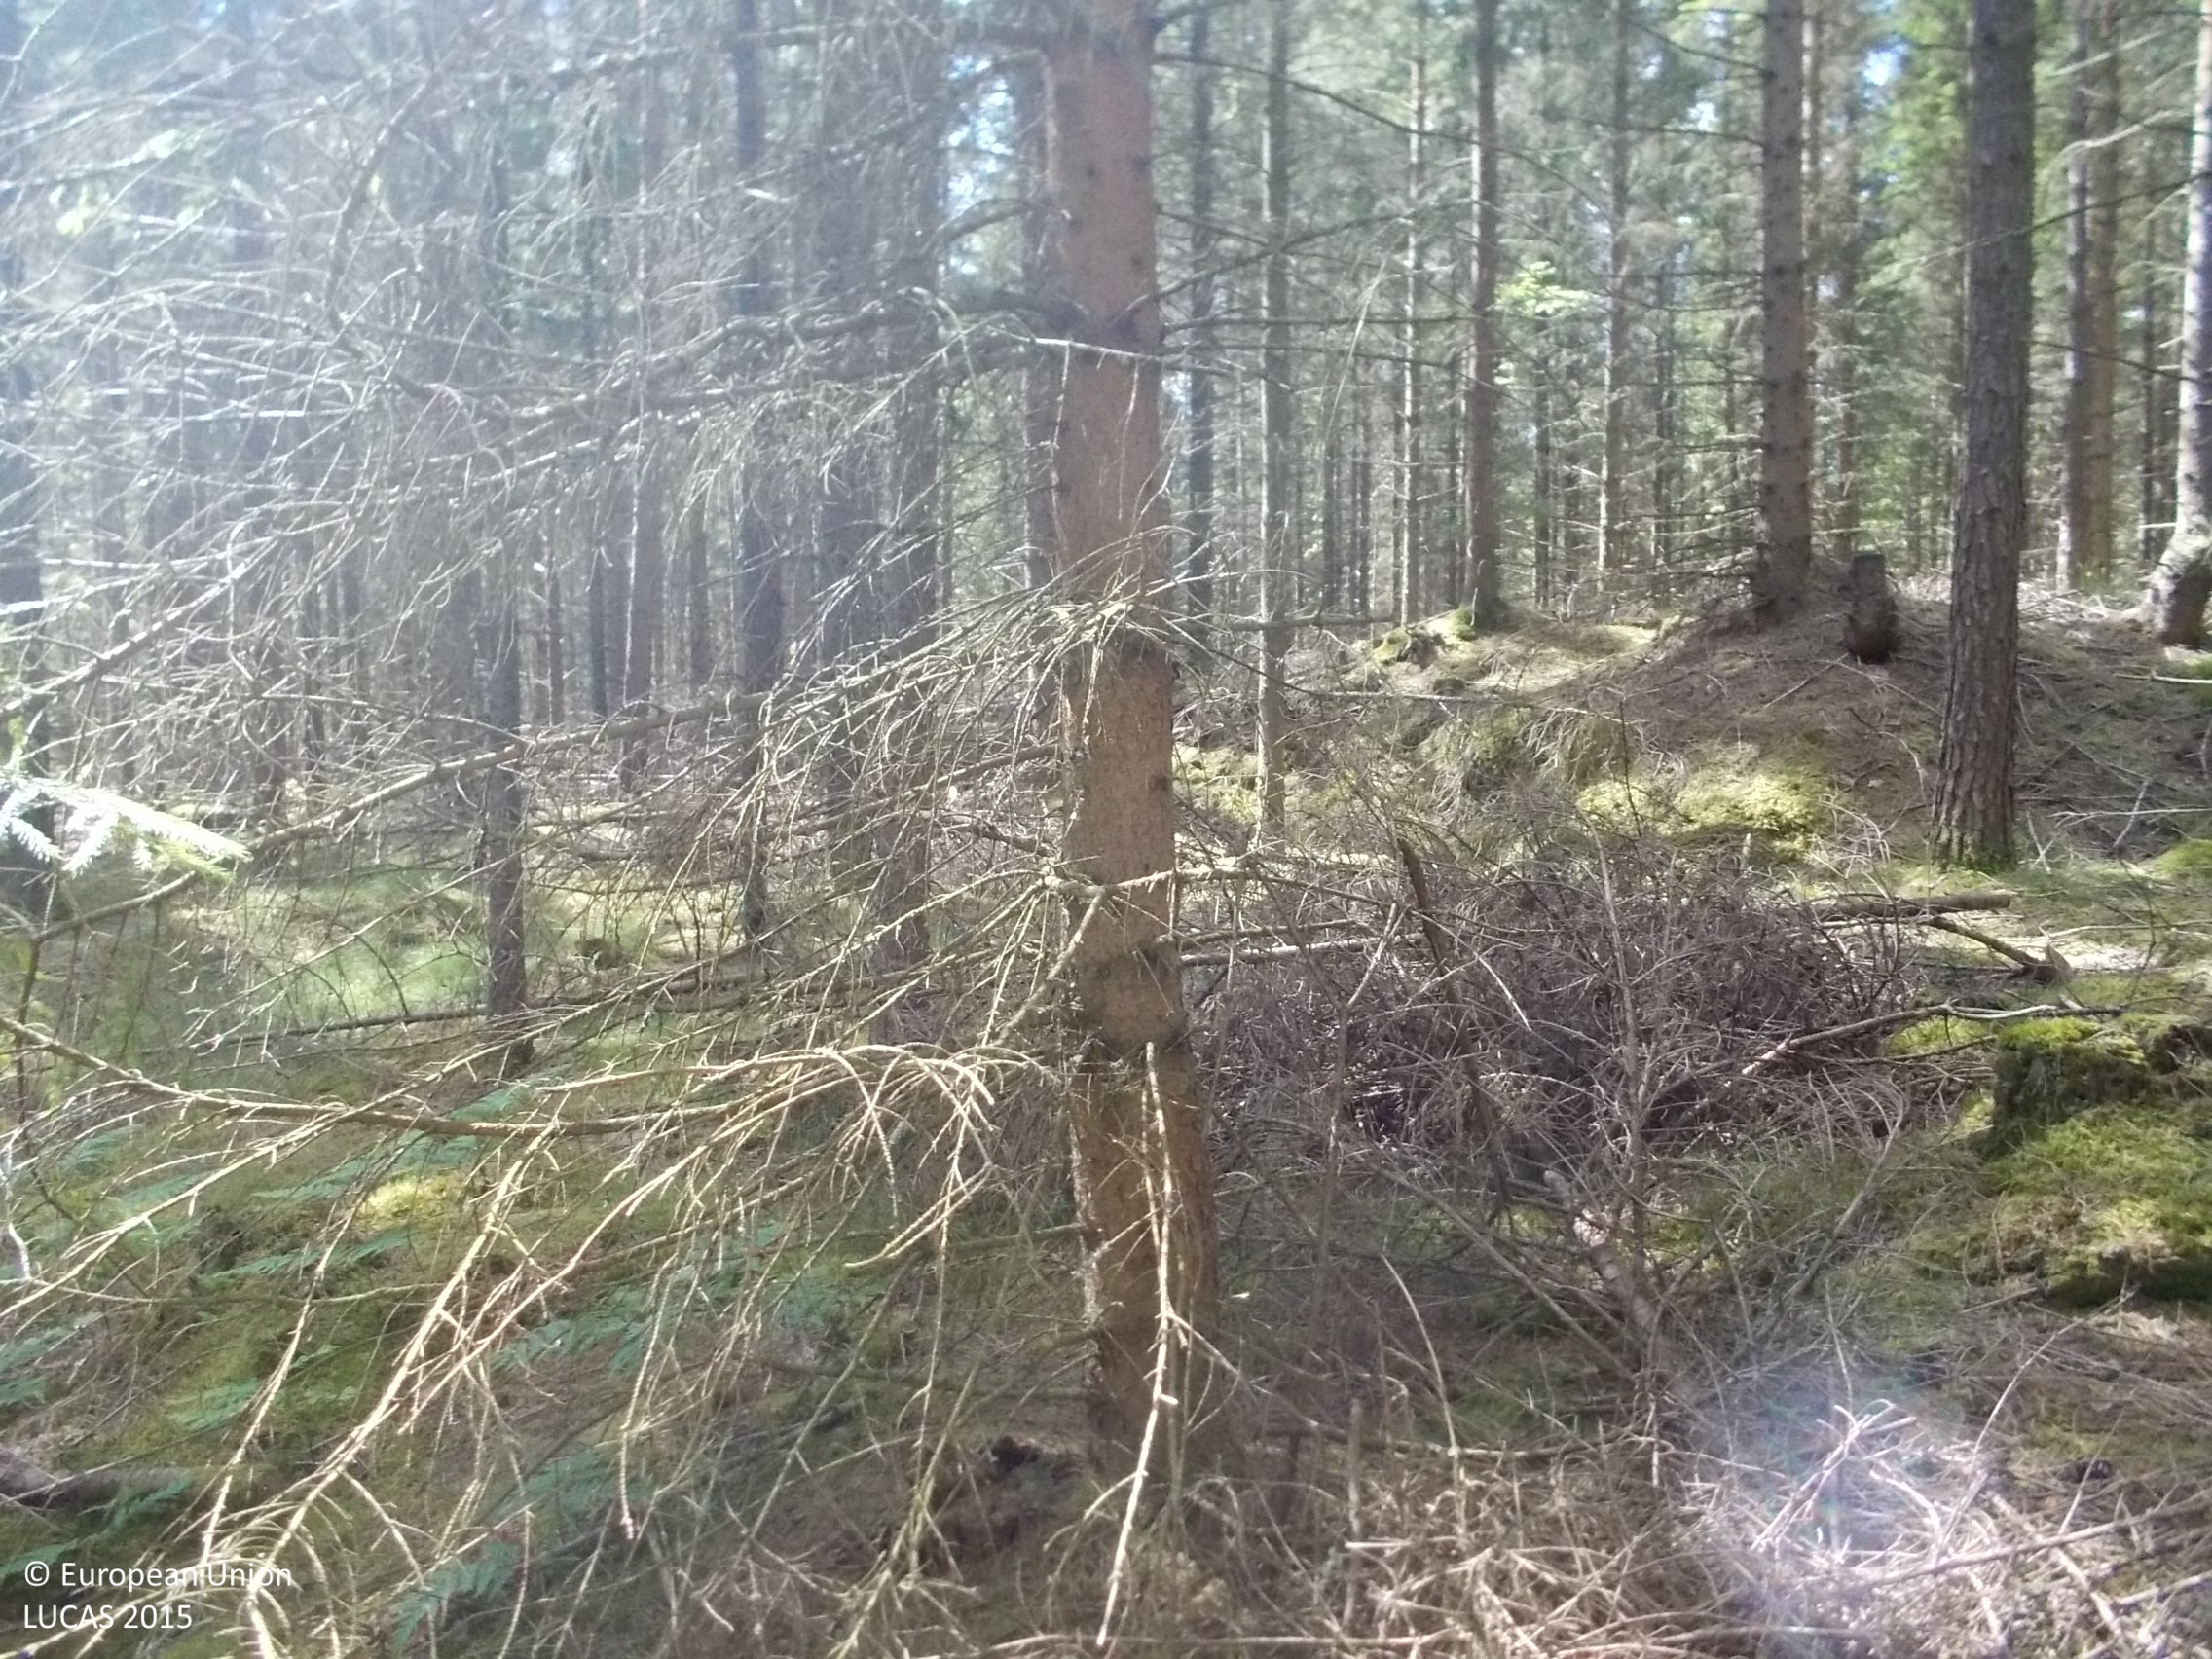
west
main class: Woodland
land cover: Spruce dominated coniferous woodland
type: boreal forest
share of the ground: > 75 %
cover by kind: coniferous forest trees 90 %, herbaceous plants 5 %, lichens and mosses 5 %
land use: Forestry
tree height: > 5 m
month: June
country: SE
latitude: 57.3206
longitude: 13.0681
